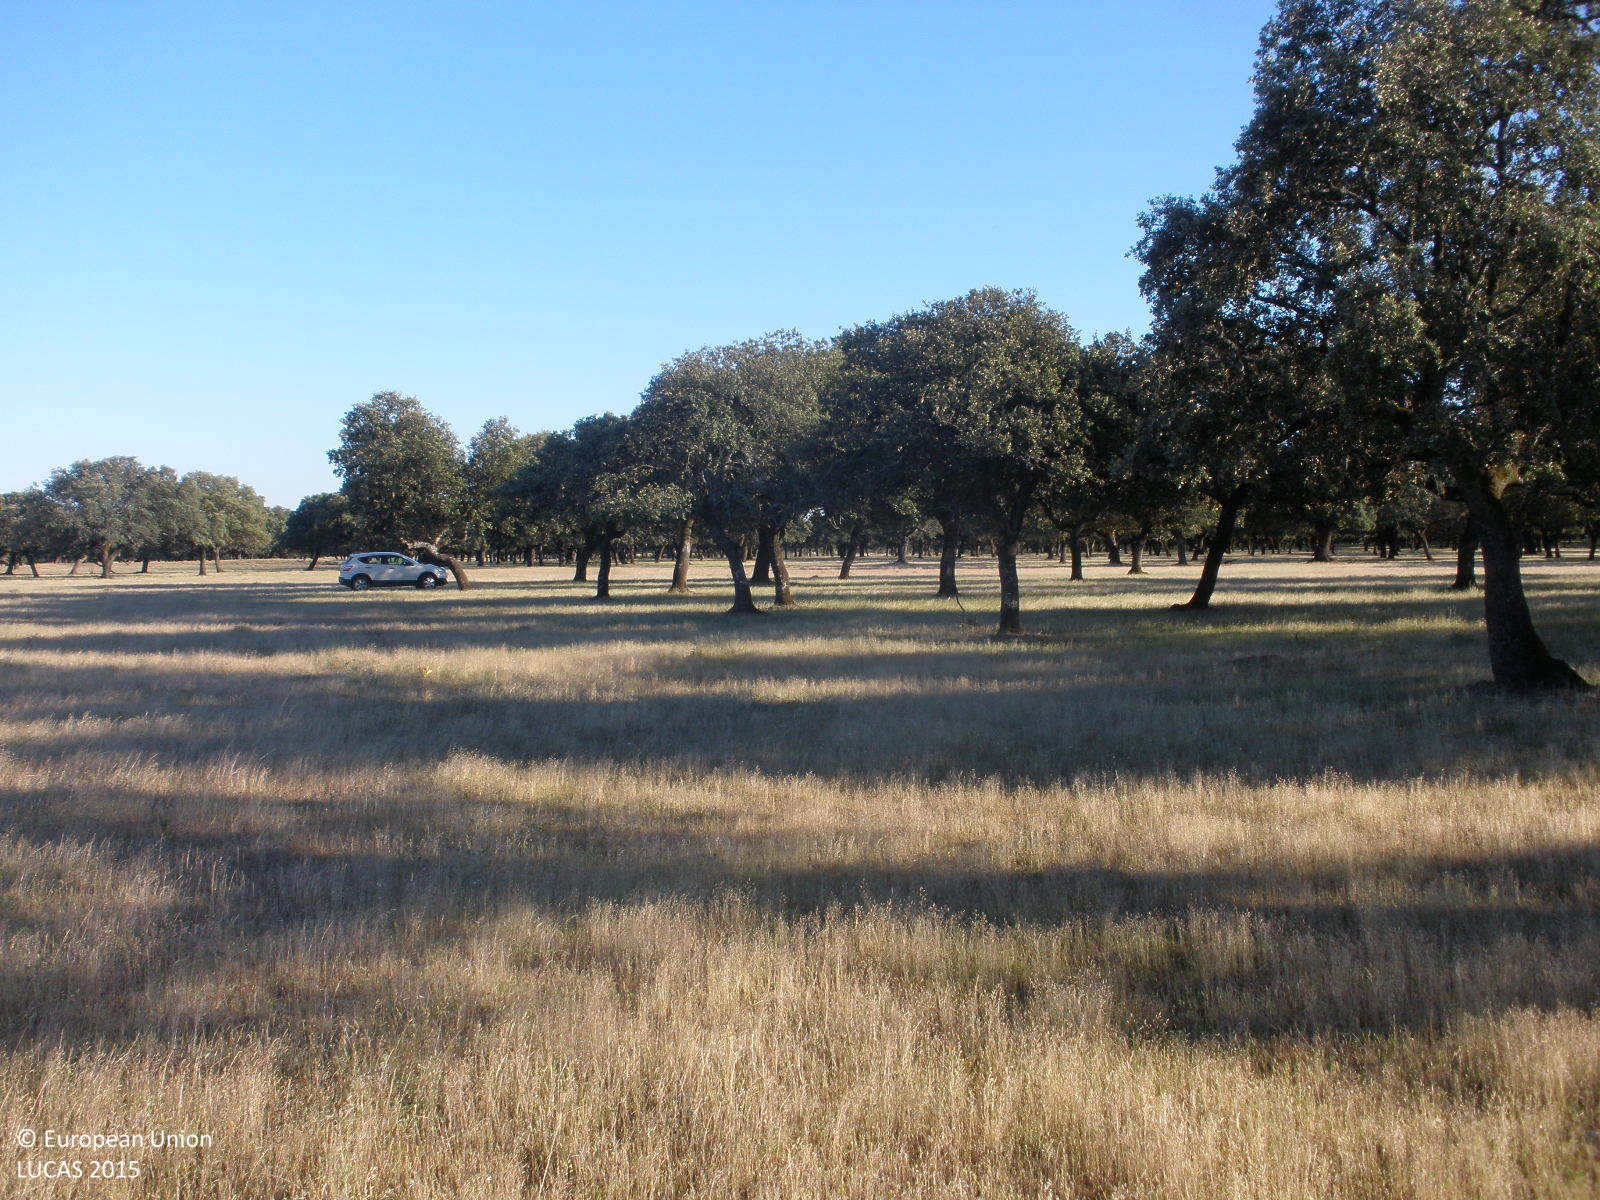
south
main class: Grassland
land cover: Grassland with sparse tree/shrub cover
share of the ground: > 75 %
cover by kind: herbaceous plants 95 %, broadleaved forest trees 5 %
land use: Agriculture (excluding fallow land and kitchen gardens)
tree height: > 5 m
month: May
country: ES
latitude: 40.2199
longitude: -6.1872
